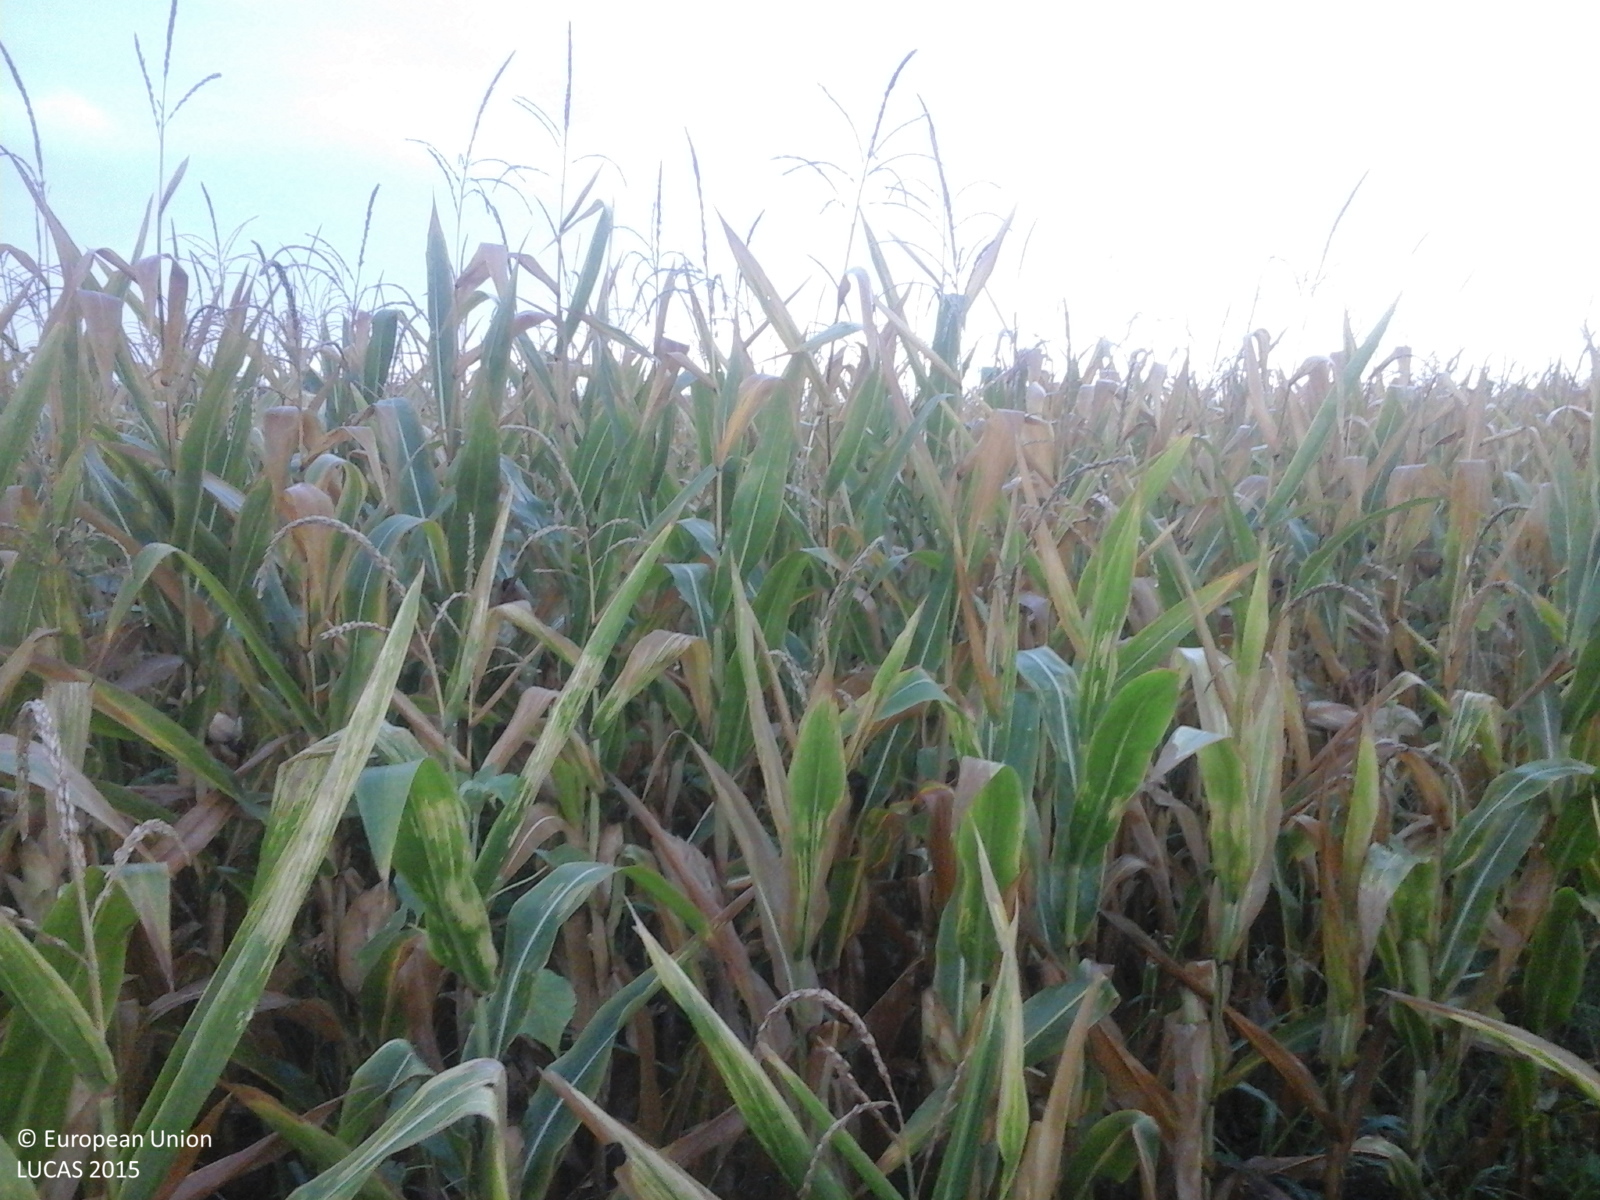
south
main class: Cropland
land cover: Maize
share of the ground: > 75 %
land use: Agriculture (excluding fallow land and kitchen gardens)
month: August
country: RO
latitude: 45.6264
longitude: 21.0976
